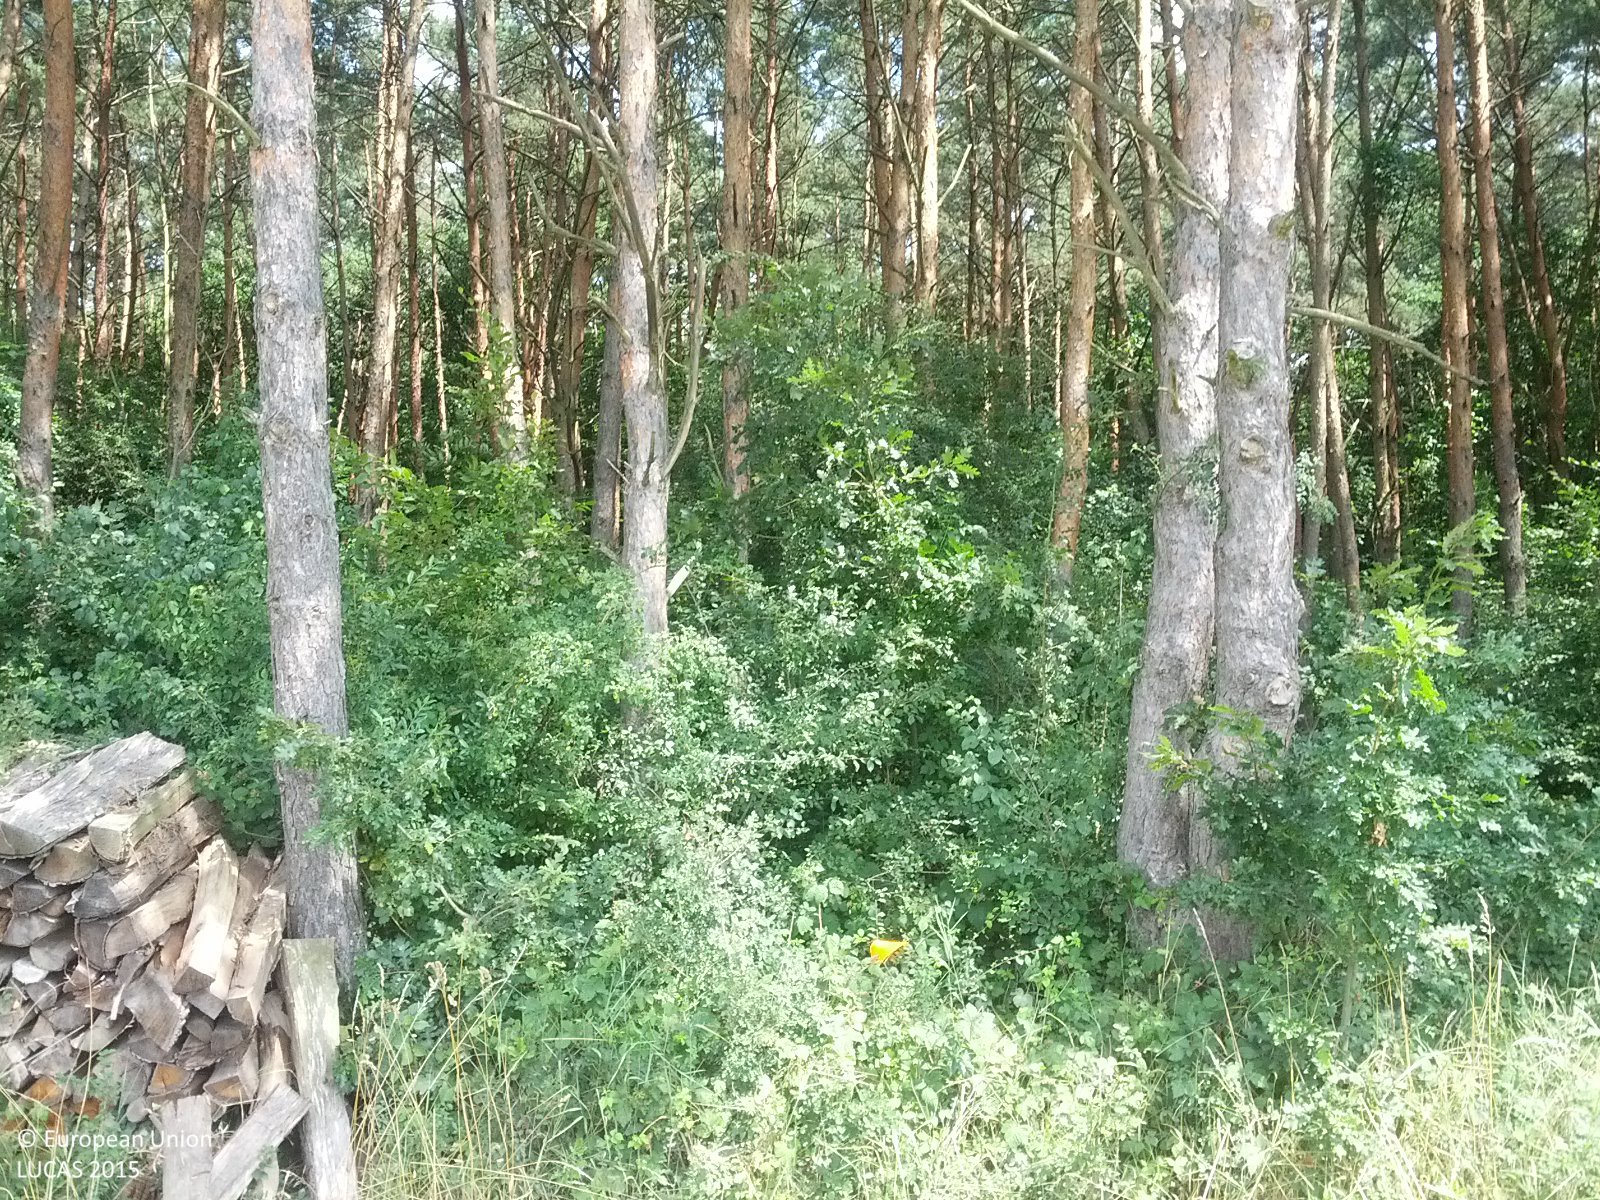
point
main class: Woodland
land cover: Pine dominated coniferous woodland
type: hemiboreal forest and nemoral coniferous forest and mixed broadleaved-coniferous forest
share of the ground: > 75 %
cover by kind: coniferous forest trees 80 %, shrubs 10 %, herbaceous plants 10 %
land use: Forestry
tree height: > 5 m
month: July
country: AT
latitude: 47.2457
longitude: 16.3575
